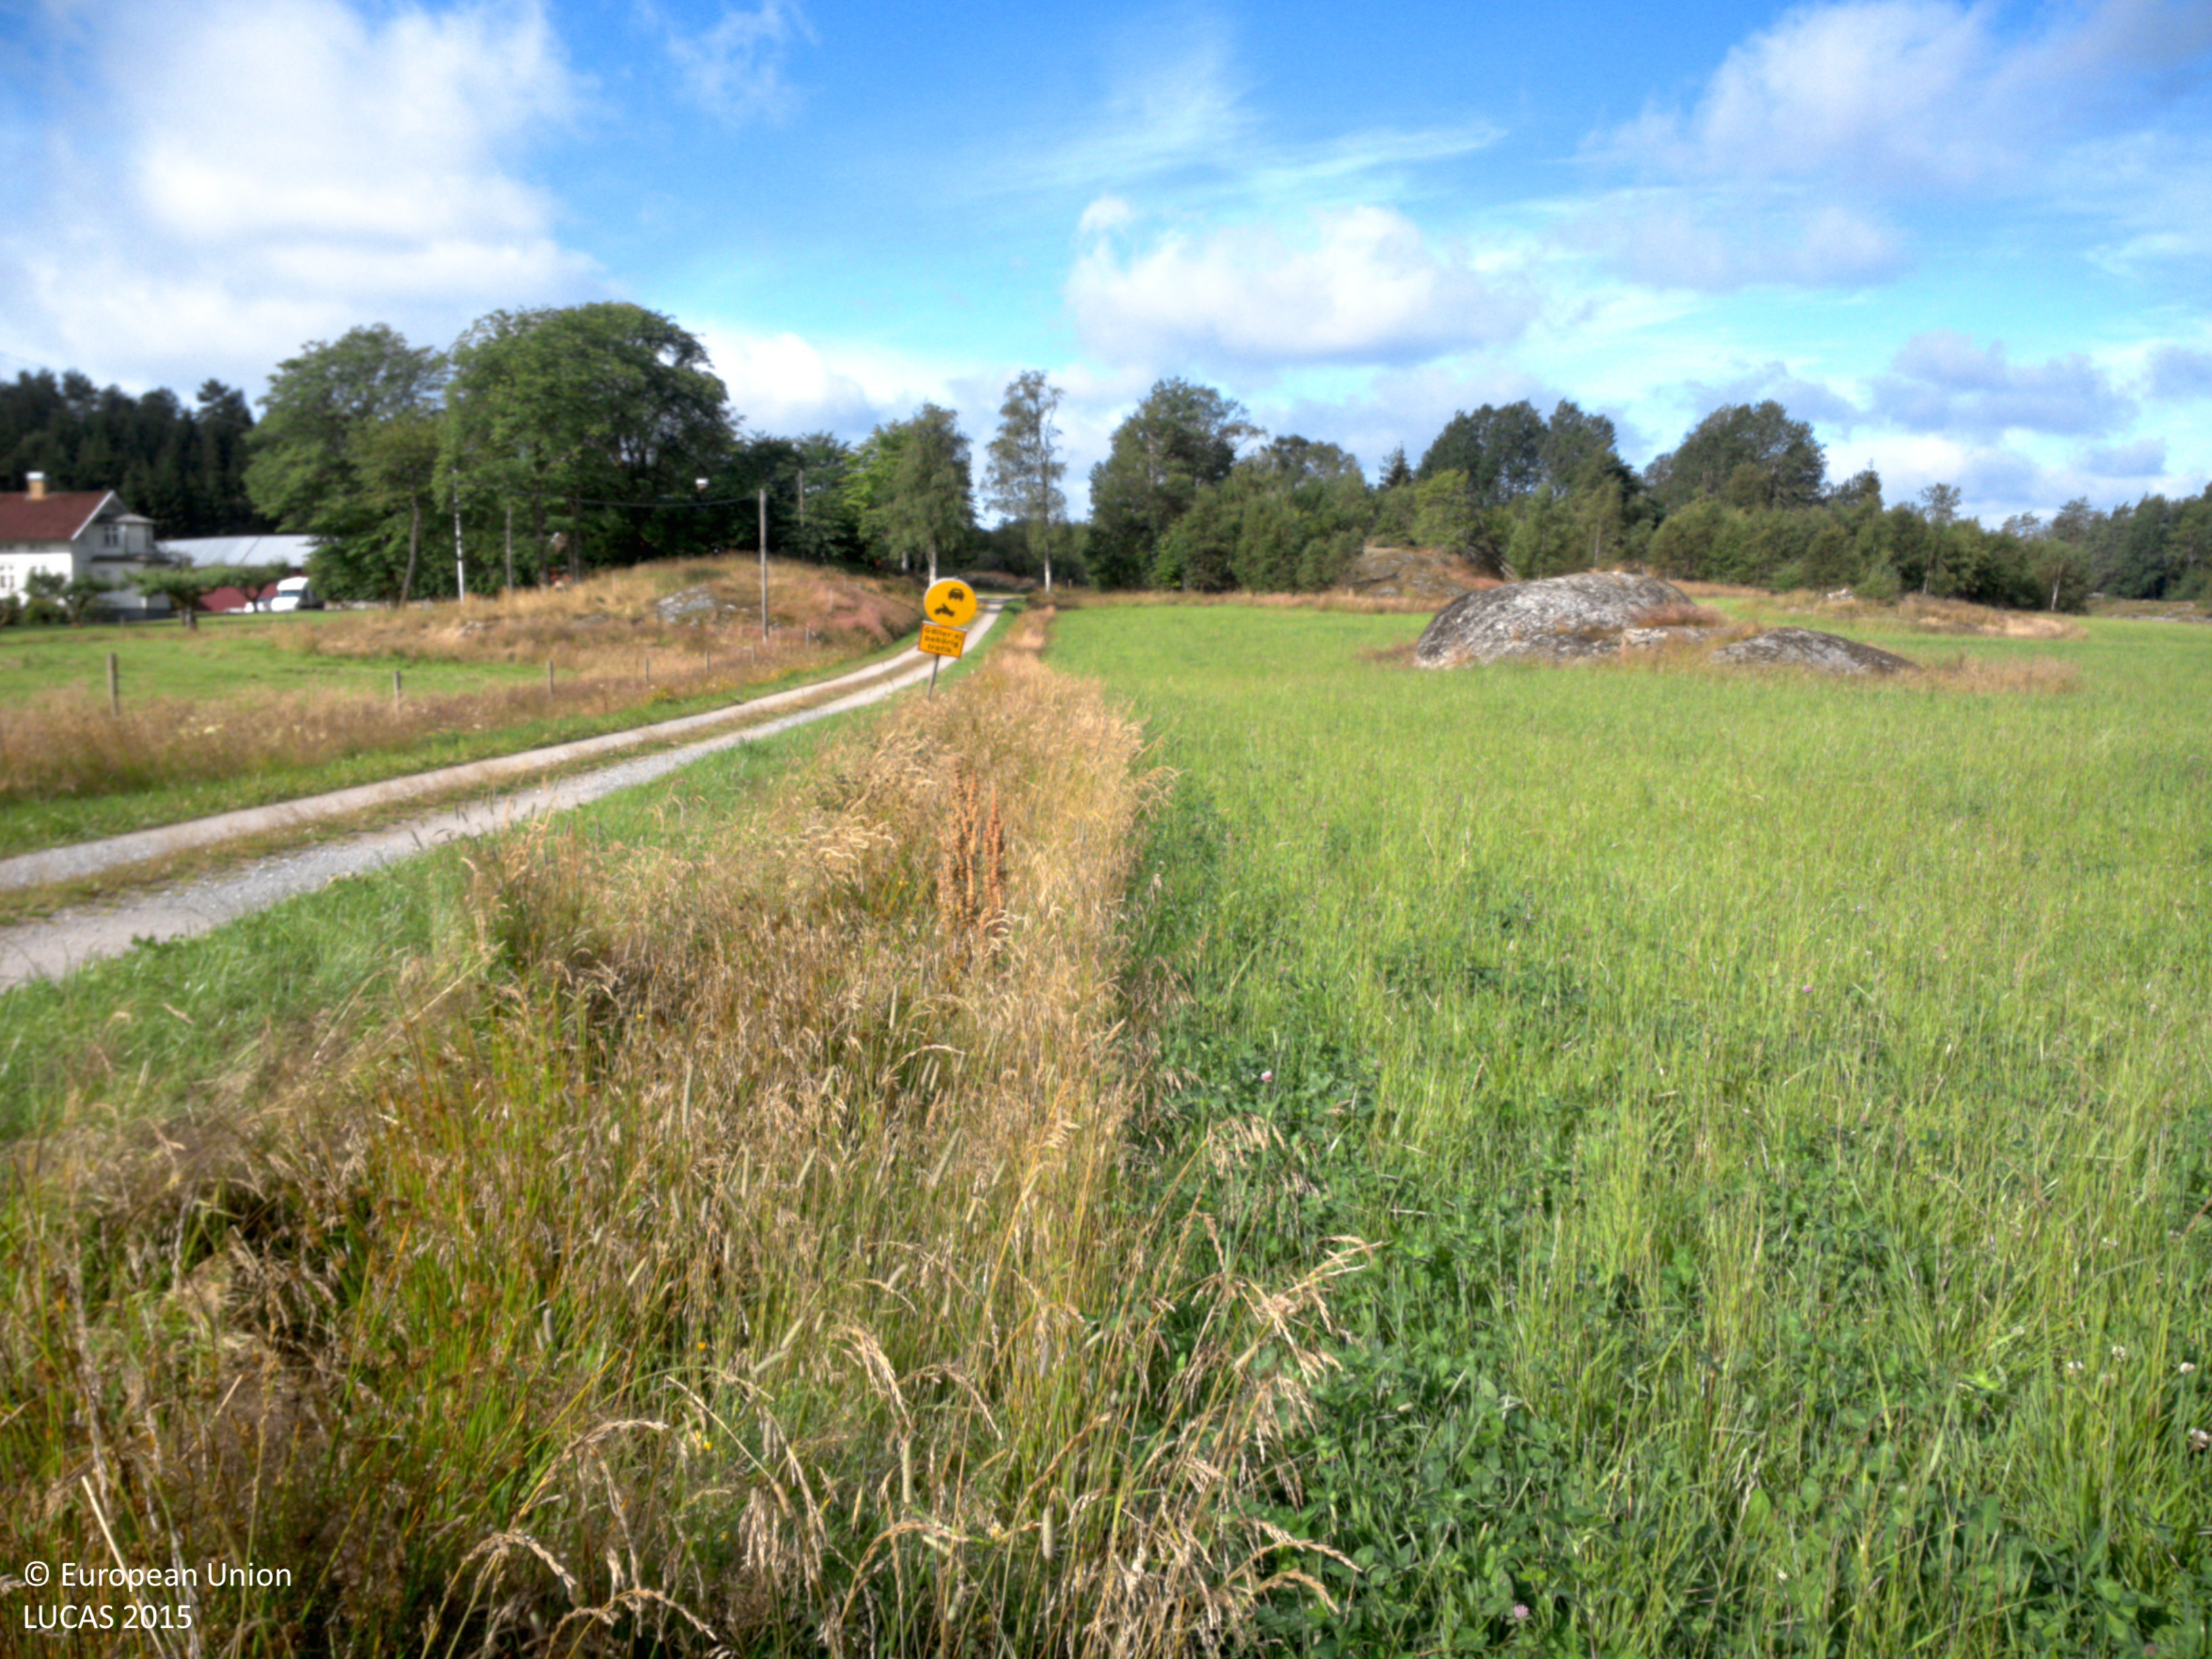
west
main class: Cropland
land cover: Temporary grasslands
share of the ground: > 75 %
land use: Agriculture (excluding fallow land and kitchen gardens)
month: July
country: SE
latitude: 58.1918
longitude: 11.6128
